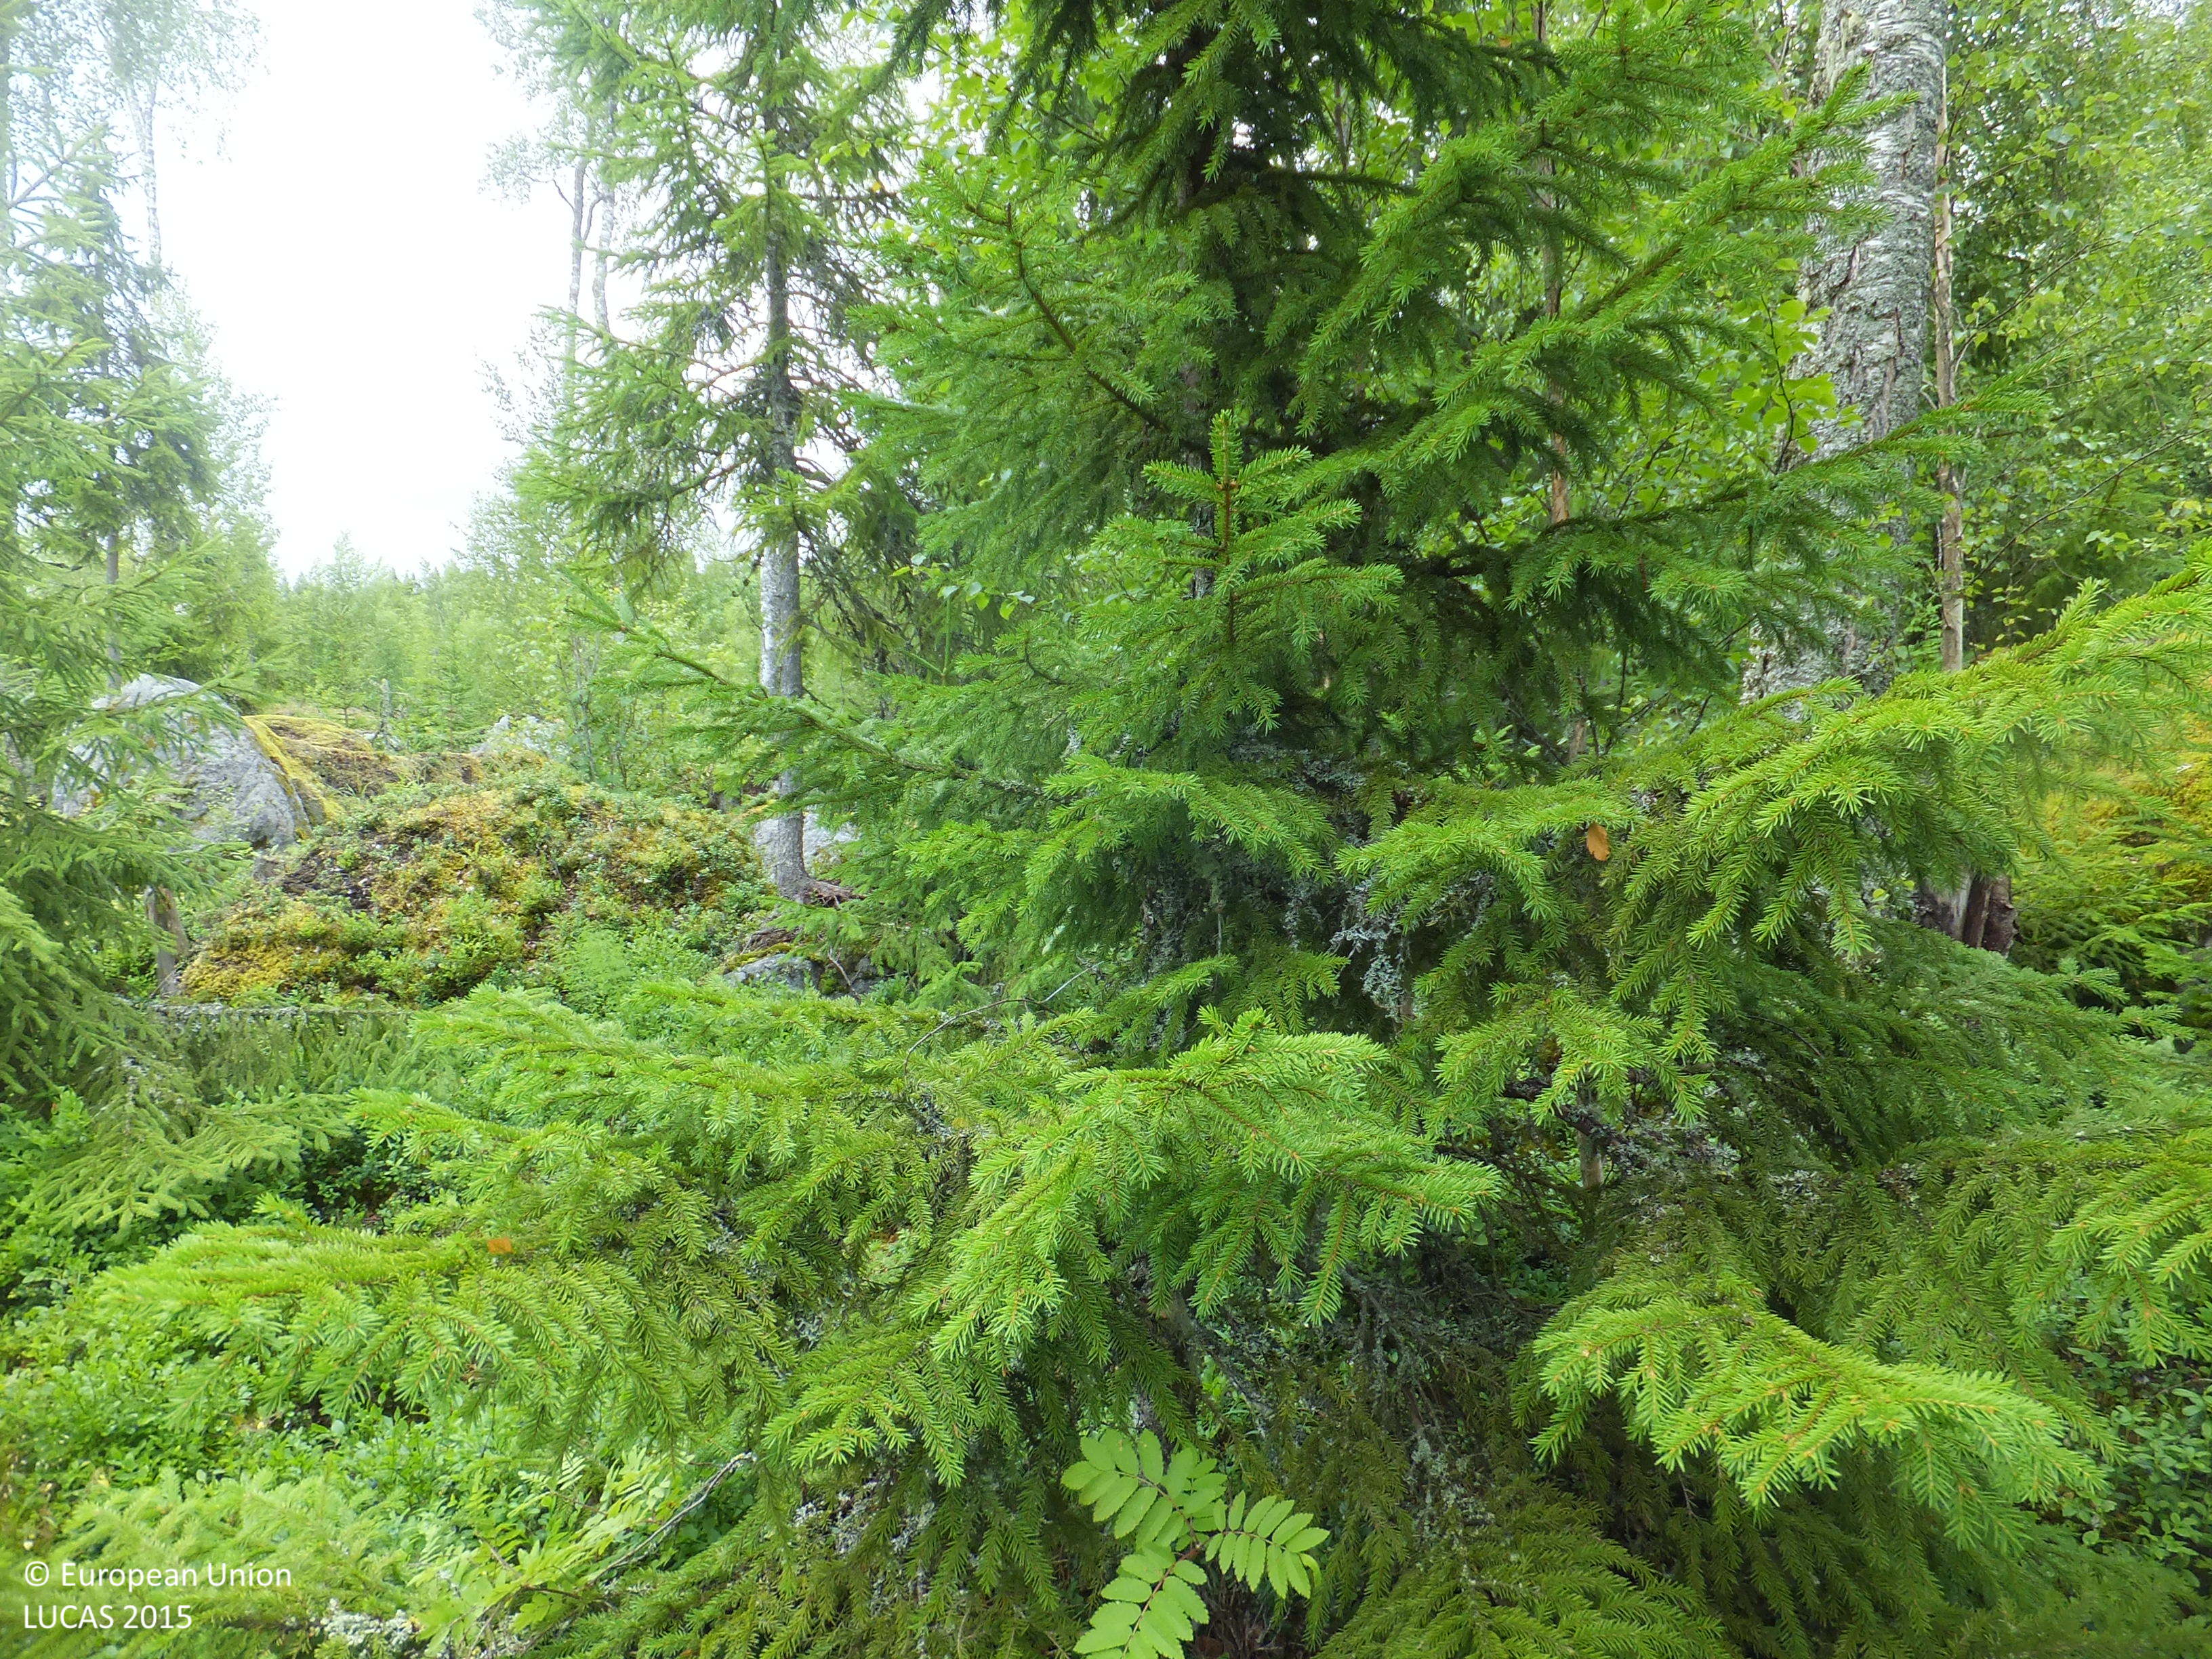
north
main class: Woodland
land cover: Spruce dominated mixed woodland
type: boreal forest
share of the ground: 25 - 50 %
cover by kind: shrubs 30 %, coniferous forest trees 25 %, broadleaved forest trees 20 %, lichens and mosses 10 %, consolidated bare surface 10 %, herbaceous plants 5 %
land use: Forestry
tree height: > 5 m
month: July
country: FI
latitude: 63.0562
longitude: 21.8527
